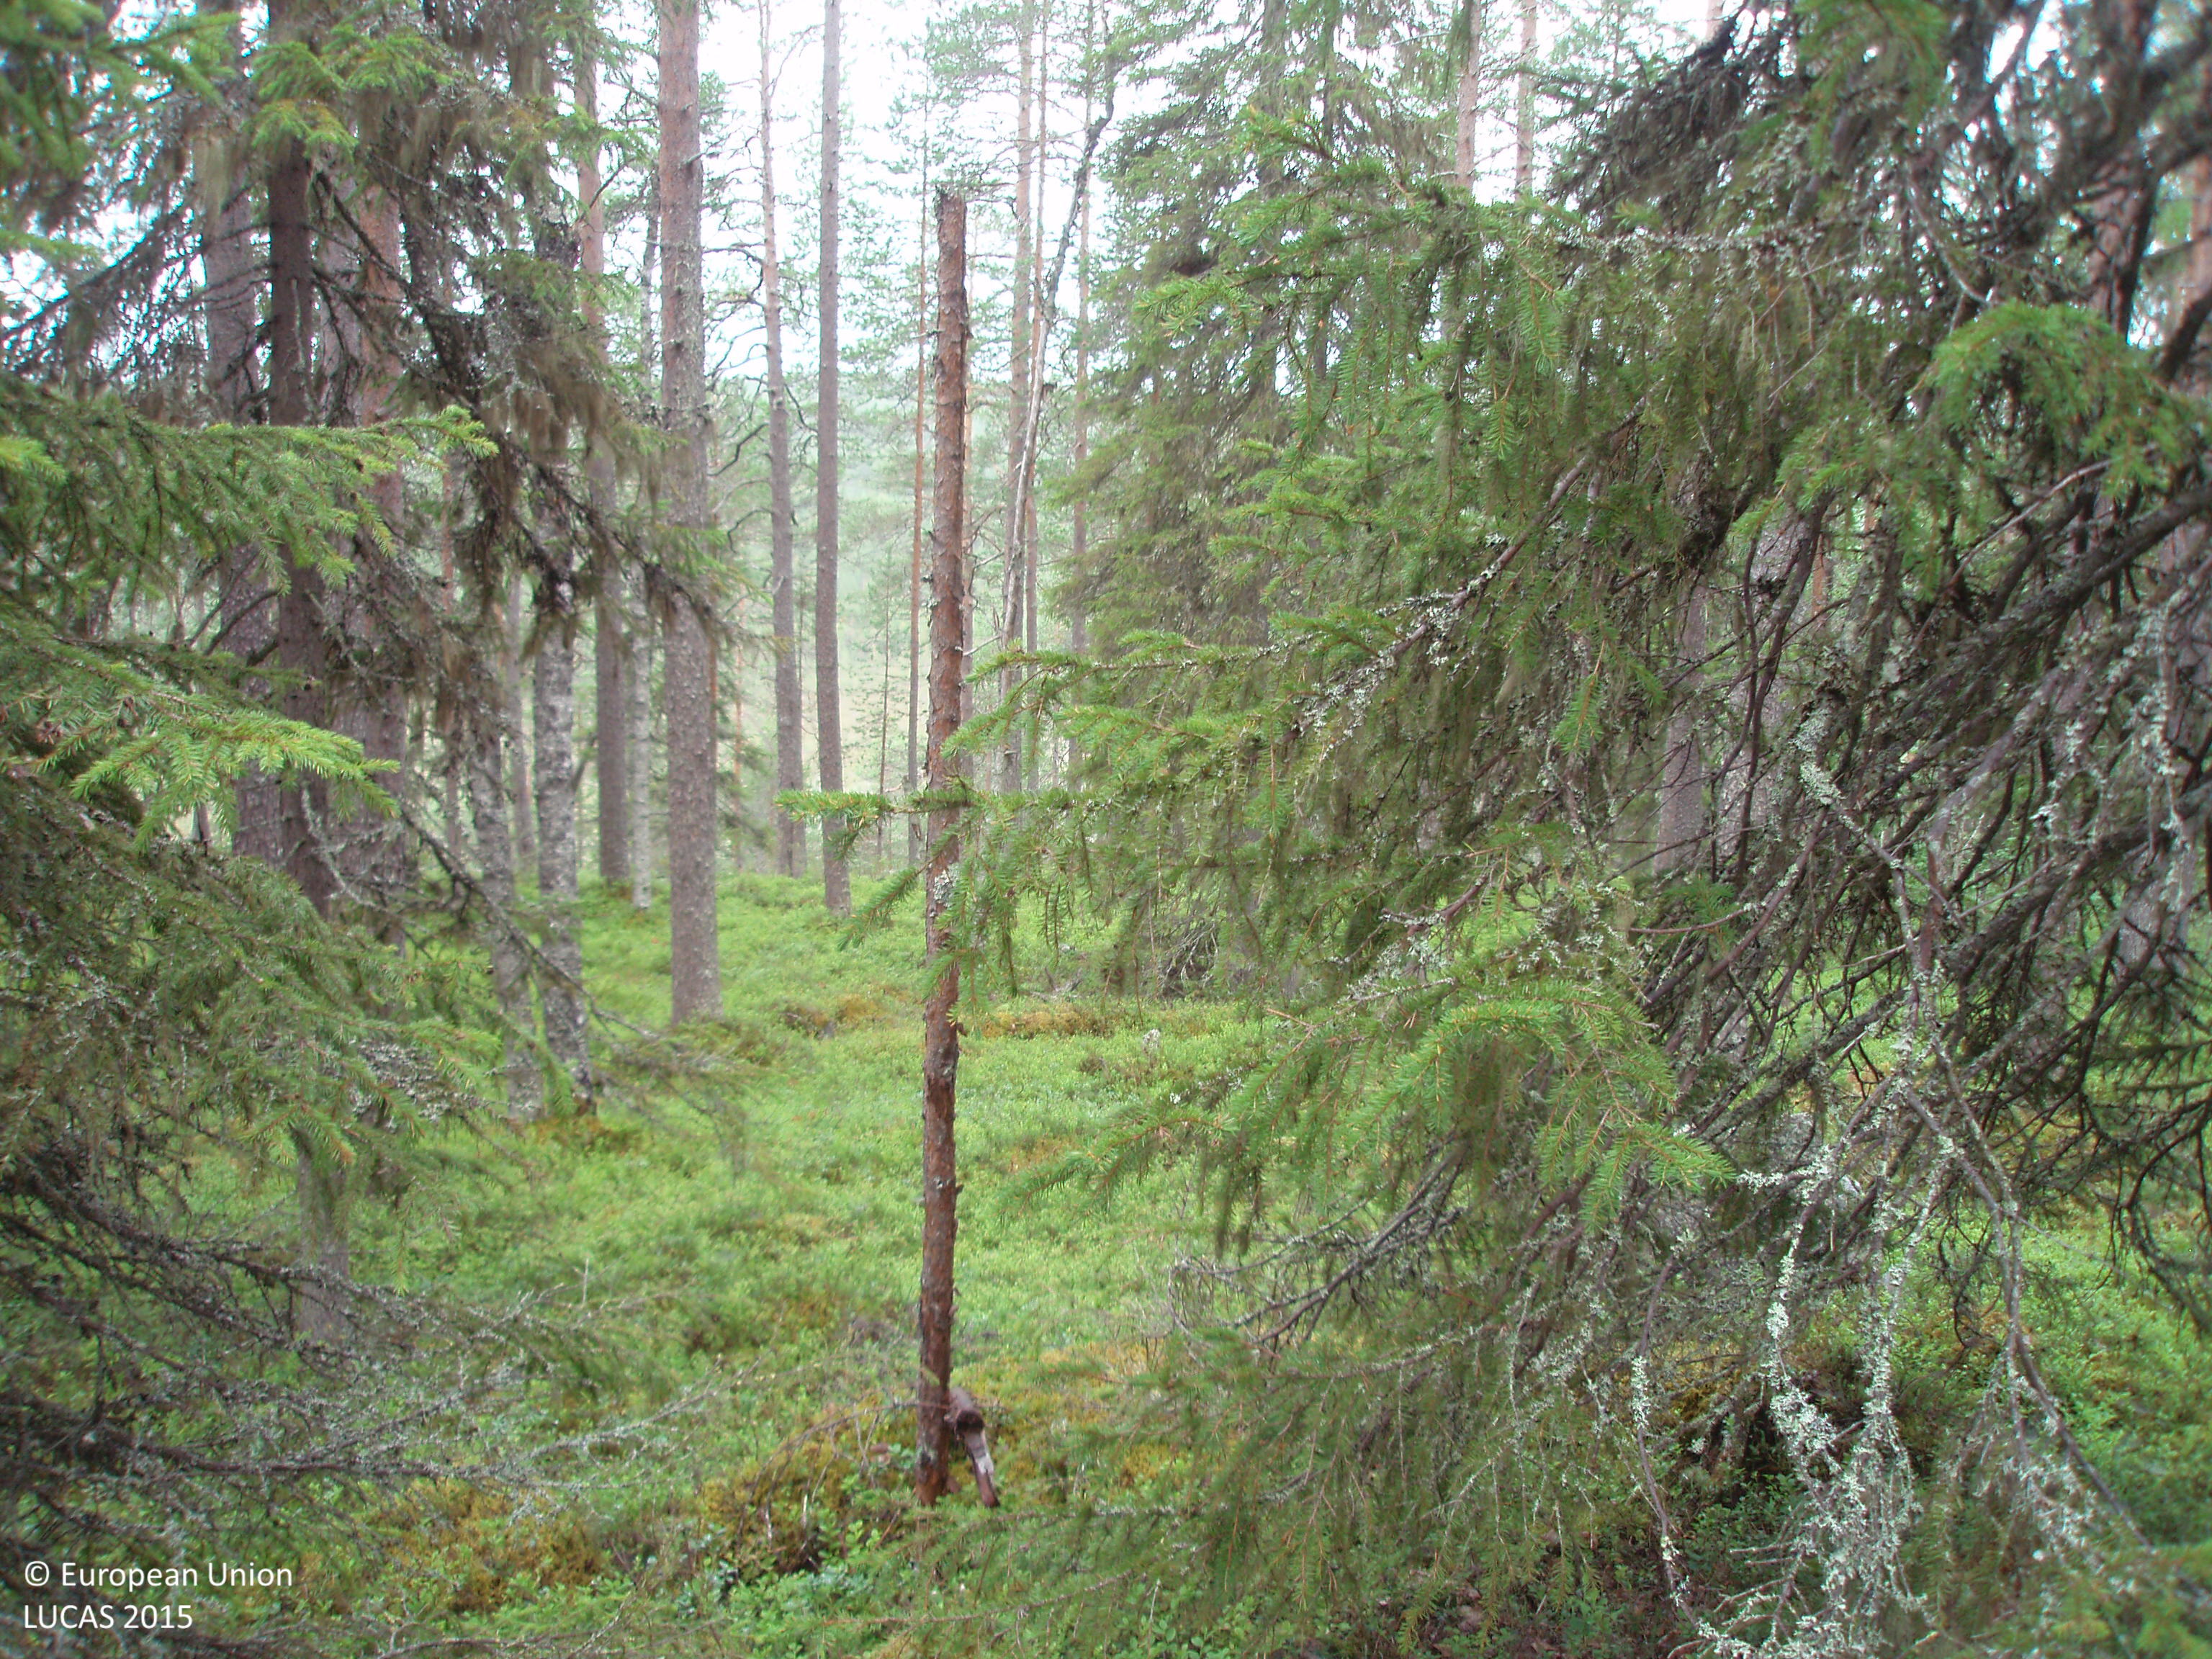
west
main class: Woodland
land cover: Other coniferous woodland
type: boreal forest
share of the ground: 50 - 75 %
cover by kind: coniferous forest trees 55 %, shrubs 30 %, broadleaved forest trees 15 %
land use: Semi-natural and natural areas not in use
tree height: > 5 m
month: August
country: FI
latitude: 65.5491
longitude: 27.3817
